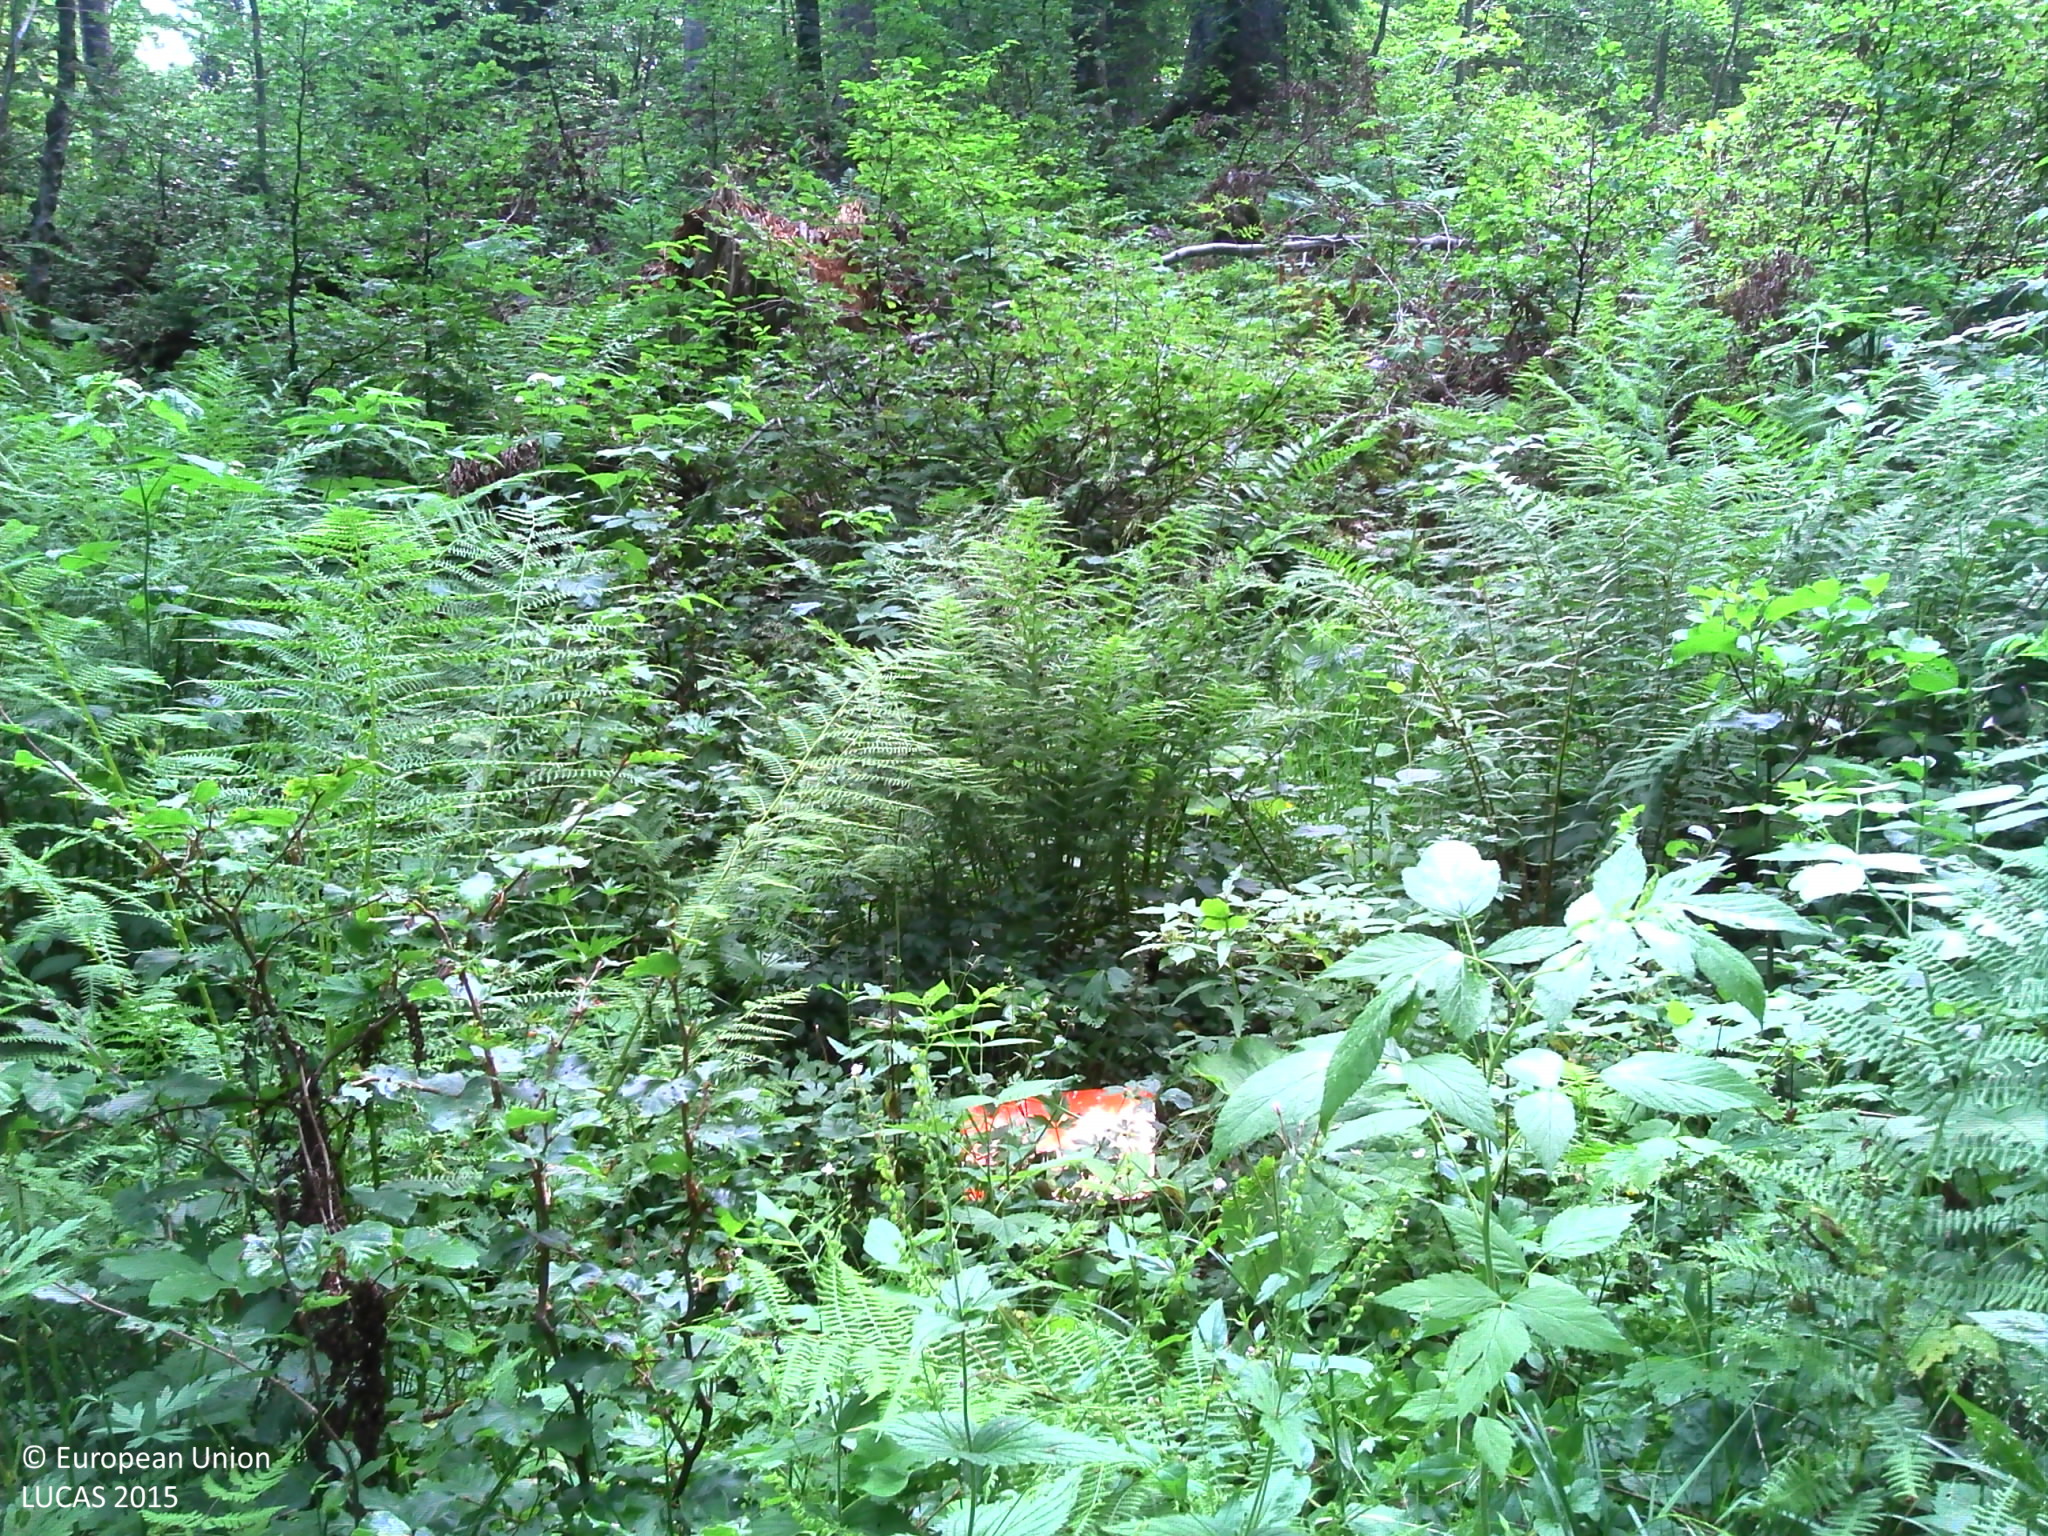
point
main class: Woodland
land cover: Spruce dominated mixed woodland
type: mountainous beech forest
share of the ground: 50 - 75 %
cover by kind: herbaceous plants 35 %, consolidated bare surface 20 %, coniferous forest trees 15 %, broadleaved forest trees 15 %, lichens and mosses 10 %, shrubs 5 %
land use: Forestry
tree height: > 5 m
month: July
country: FR
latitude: 46.5138
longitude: 6.0798
